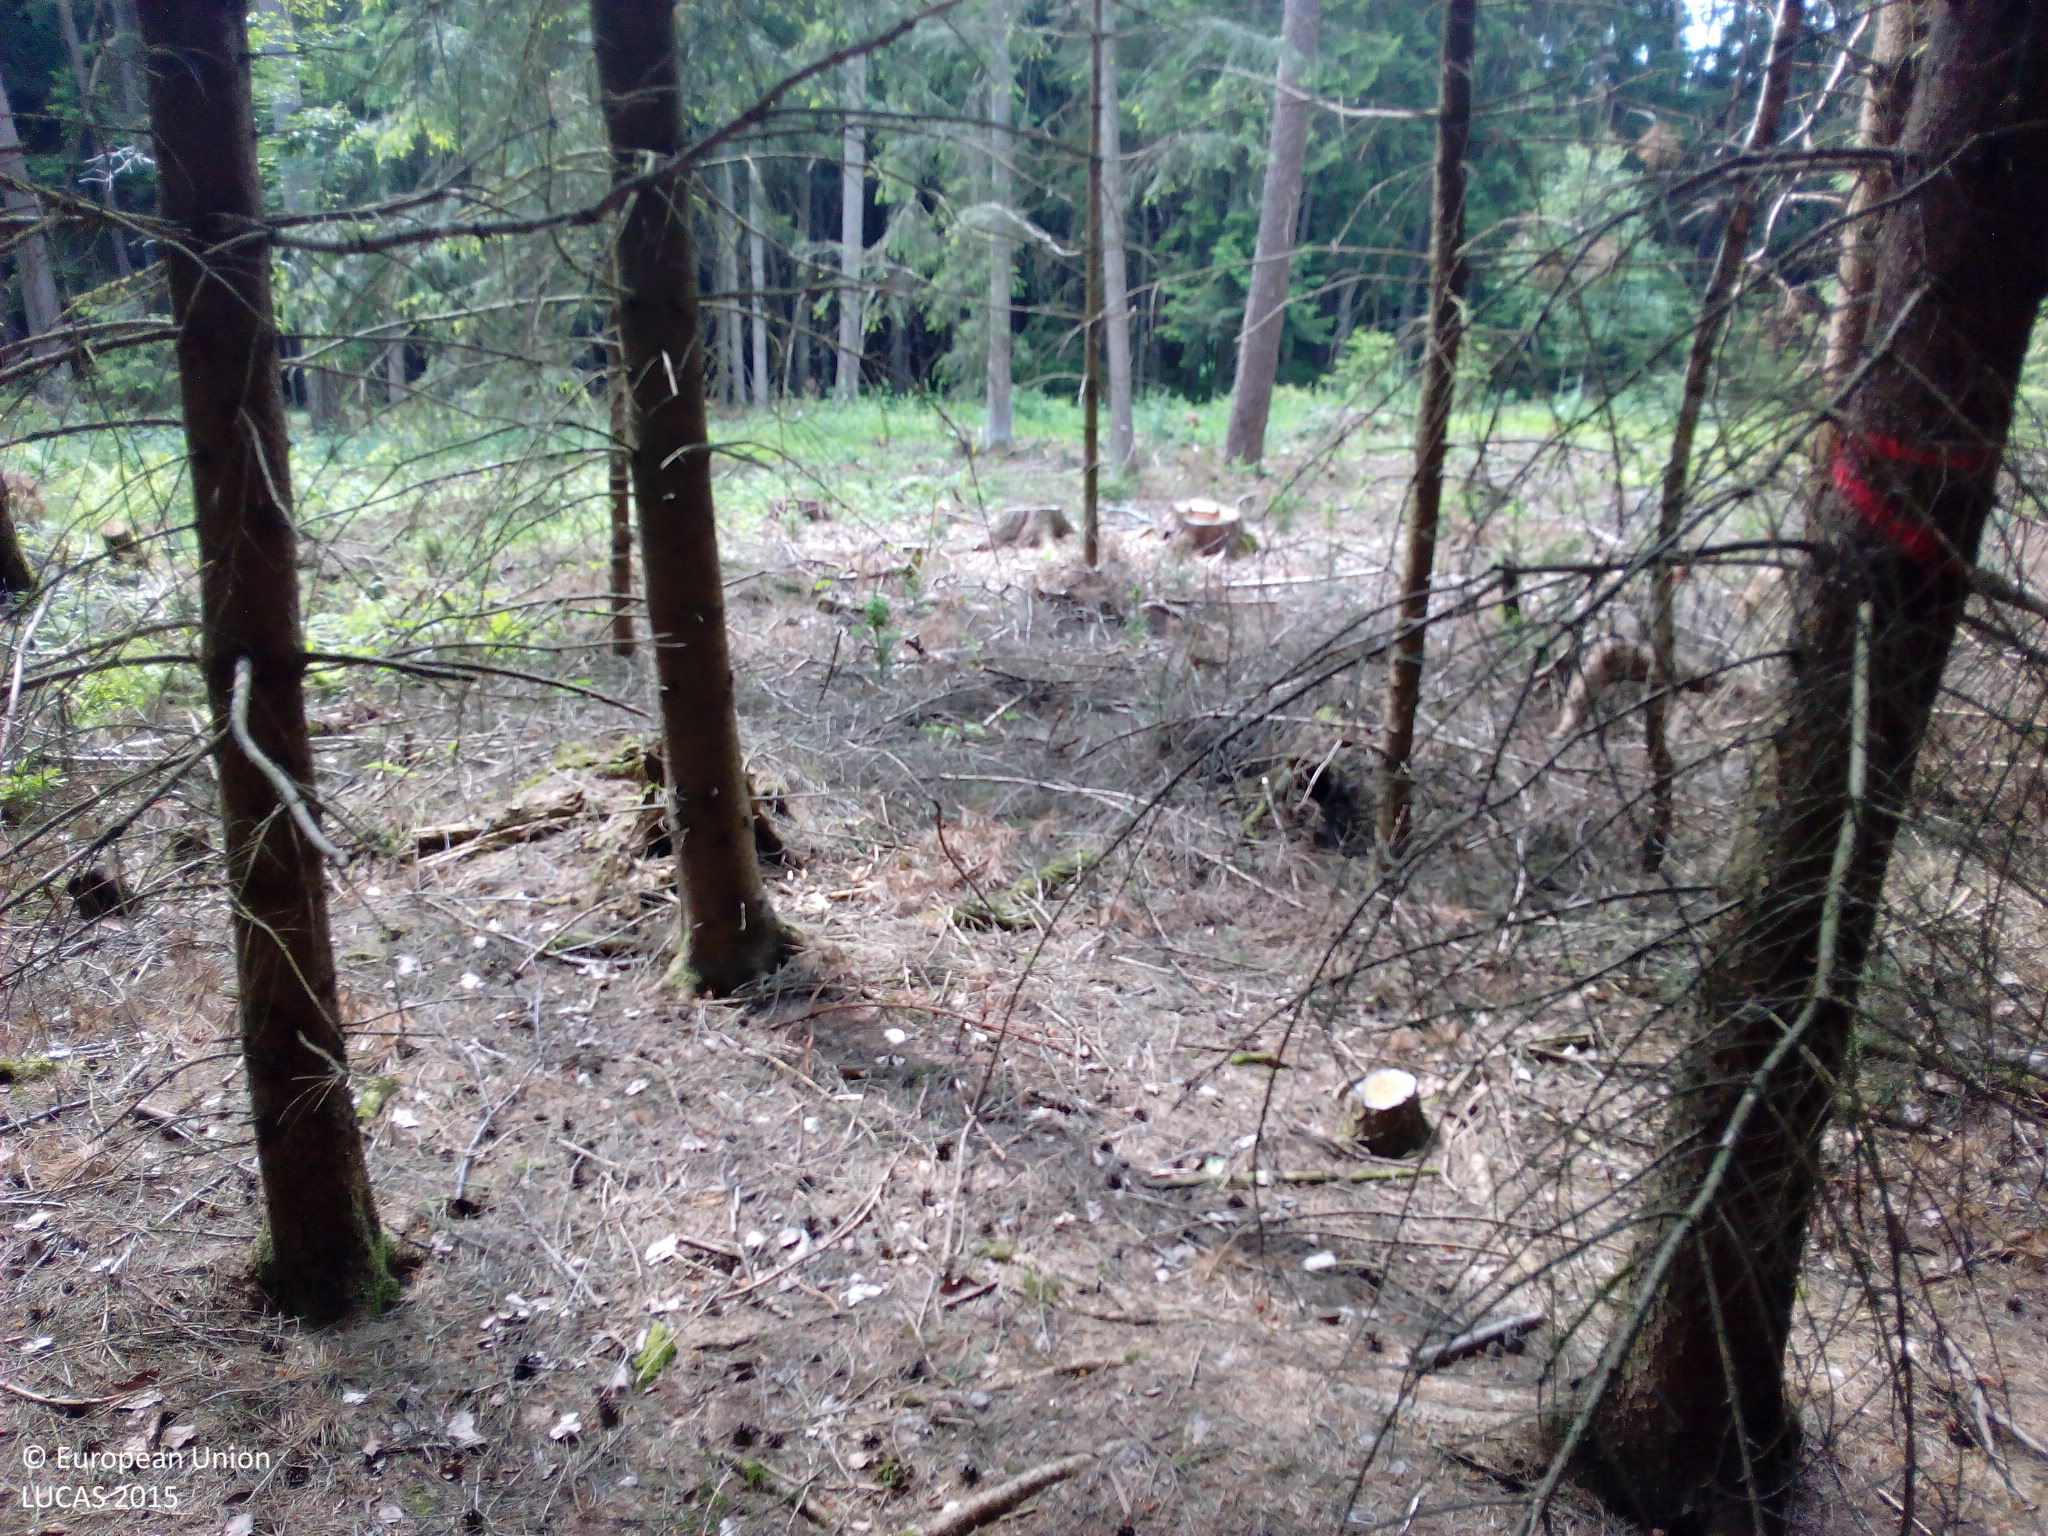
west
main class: Woodland
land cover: Spruce dominated coniferous woodland
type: hemiboreal forest and nemoral coniferous forest and mixed broadleaved-coniferous forest
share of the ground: > 75 %
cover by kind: coniferous forest trees 80 %, lichens and mosses 10 %, consolidated bare surface 10 %
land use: Forestry
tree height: > 5 m
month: June
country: DE
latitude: 48.5935
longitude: 12.3991
